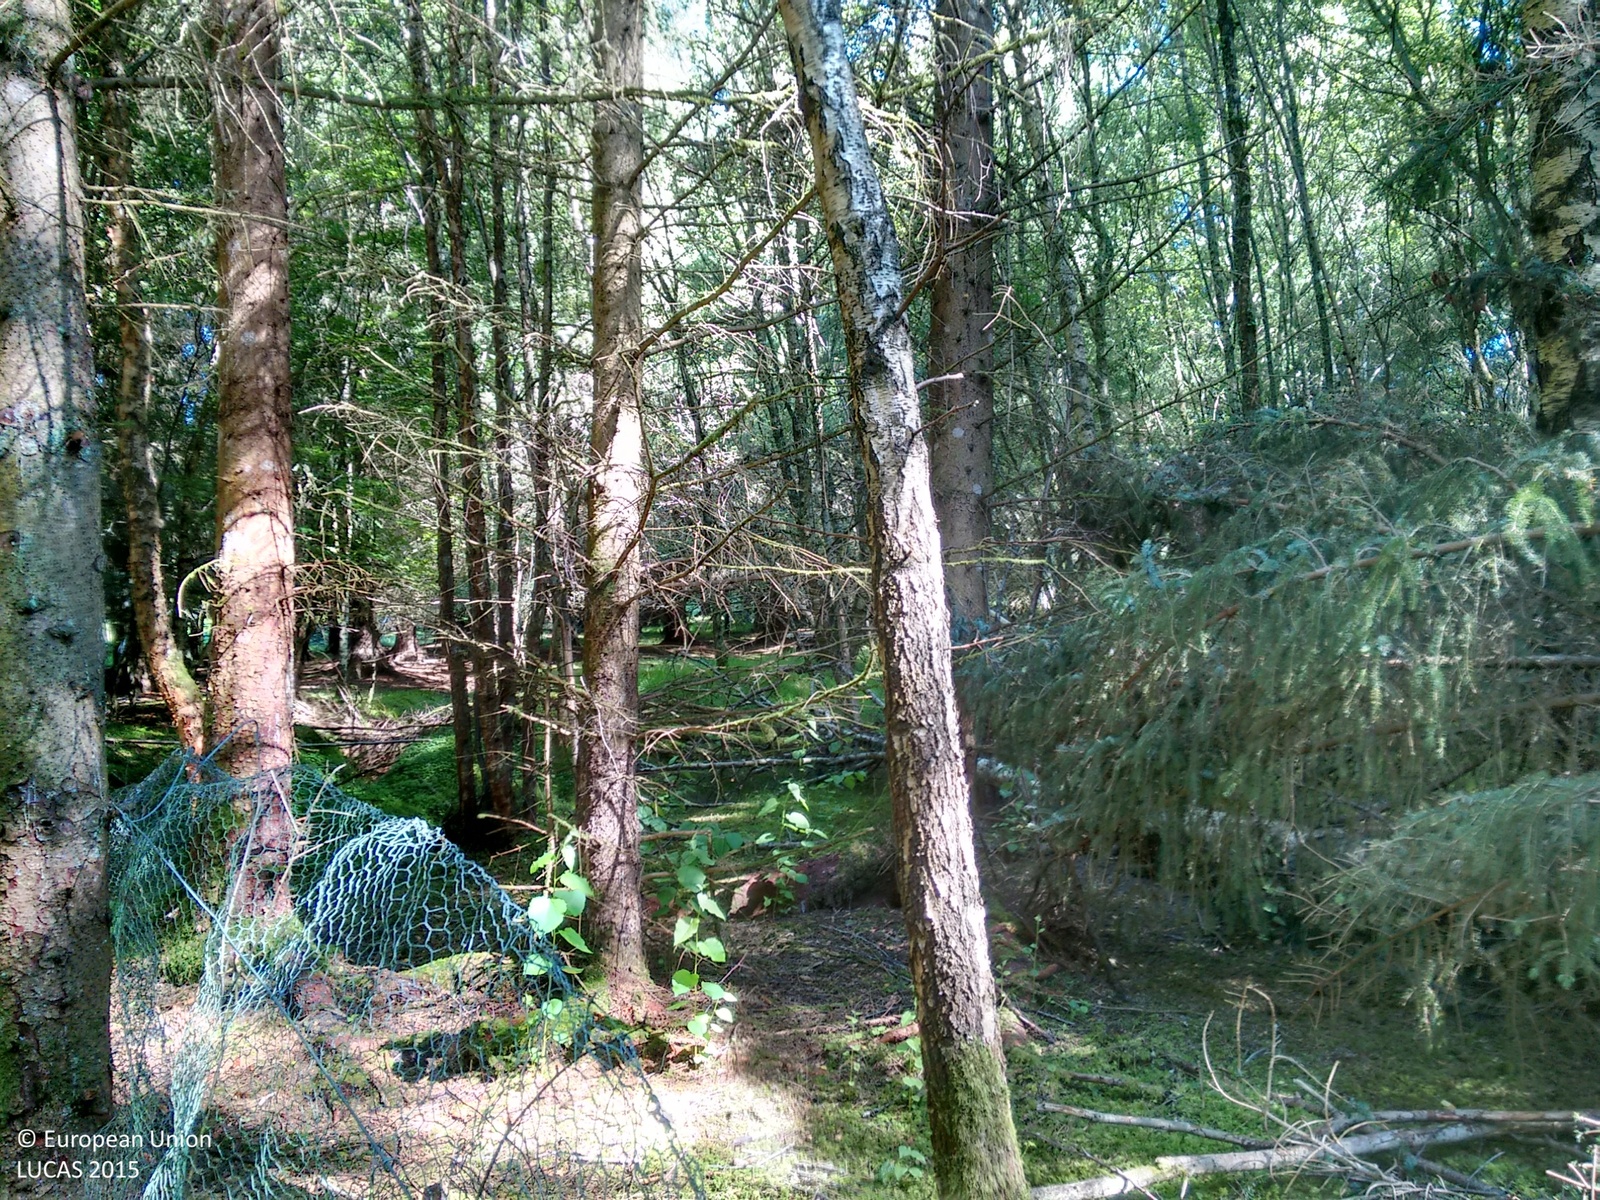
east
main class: Woodland
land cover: Spruce dominated mixed woodland
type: exotic forest
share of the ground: > 75 %
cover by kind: coniferous forest trees 70 %, broadleaved forest trees 30 %
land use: Forestry
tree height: > 5 m
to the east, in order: Spruce dominated mixed woodland; Fences; Broadleaved woodland
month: August
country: GB
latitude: 57.7515
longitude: -4.0431
